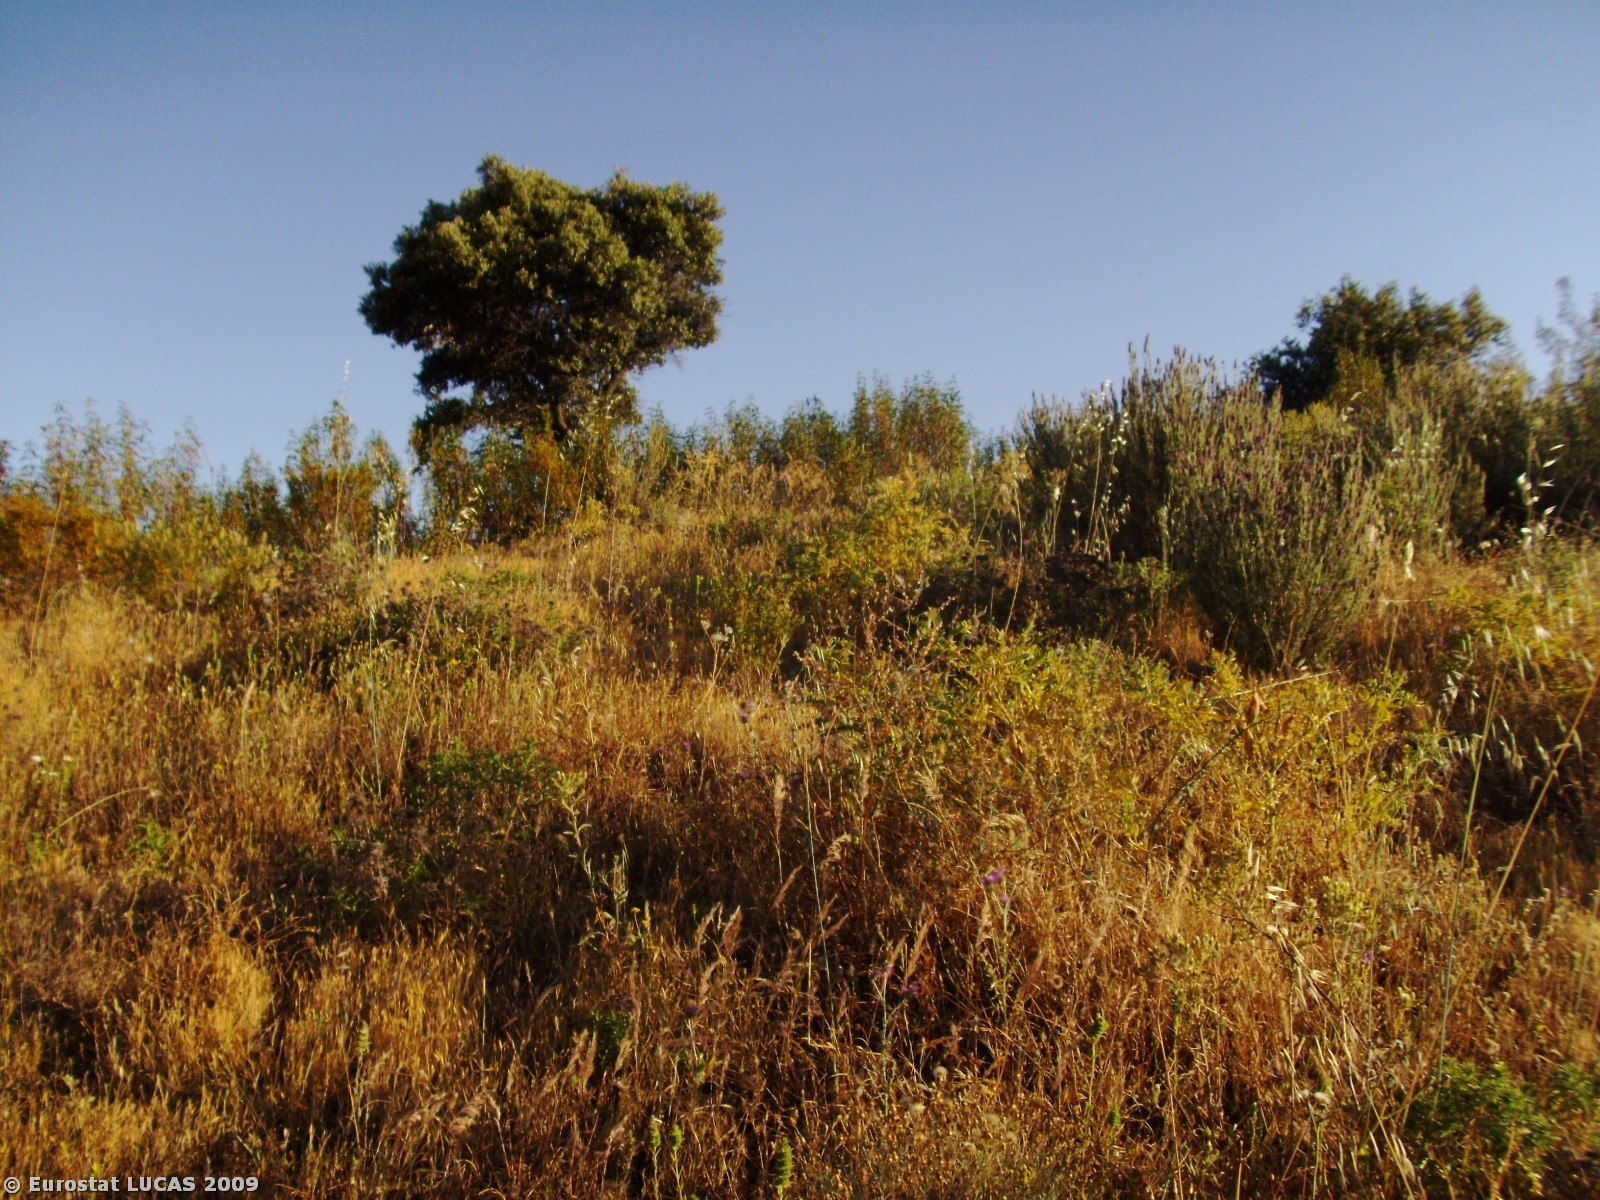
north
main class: Shrubland
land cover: Shrubland with sparse tree cover
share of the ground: < 10 %
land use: Forestry
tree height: > 5 m
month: May
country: PT
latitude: 37.3568
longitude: -7.5636
